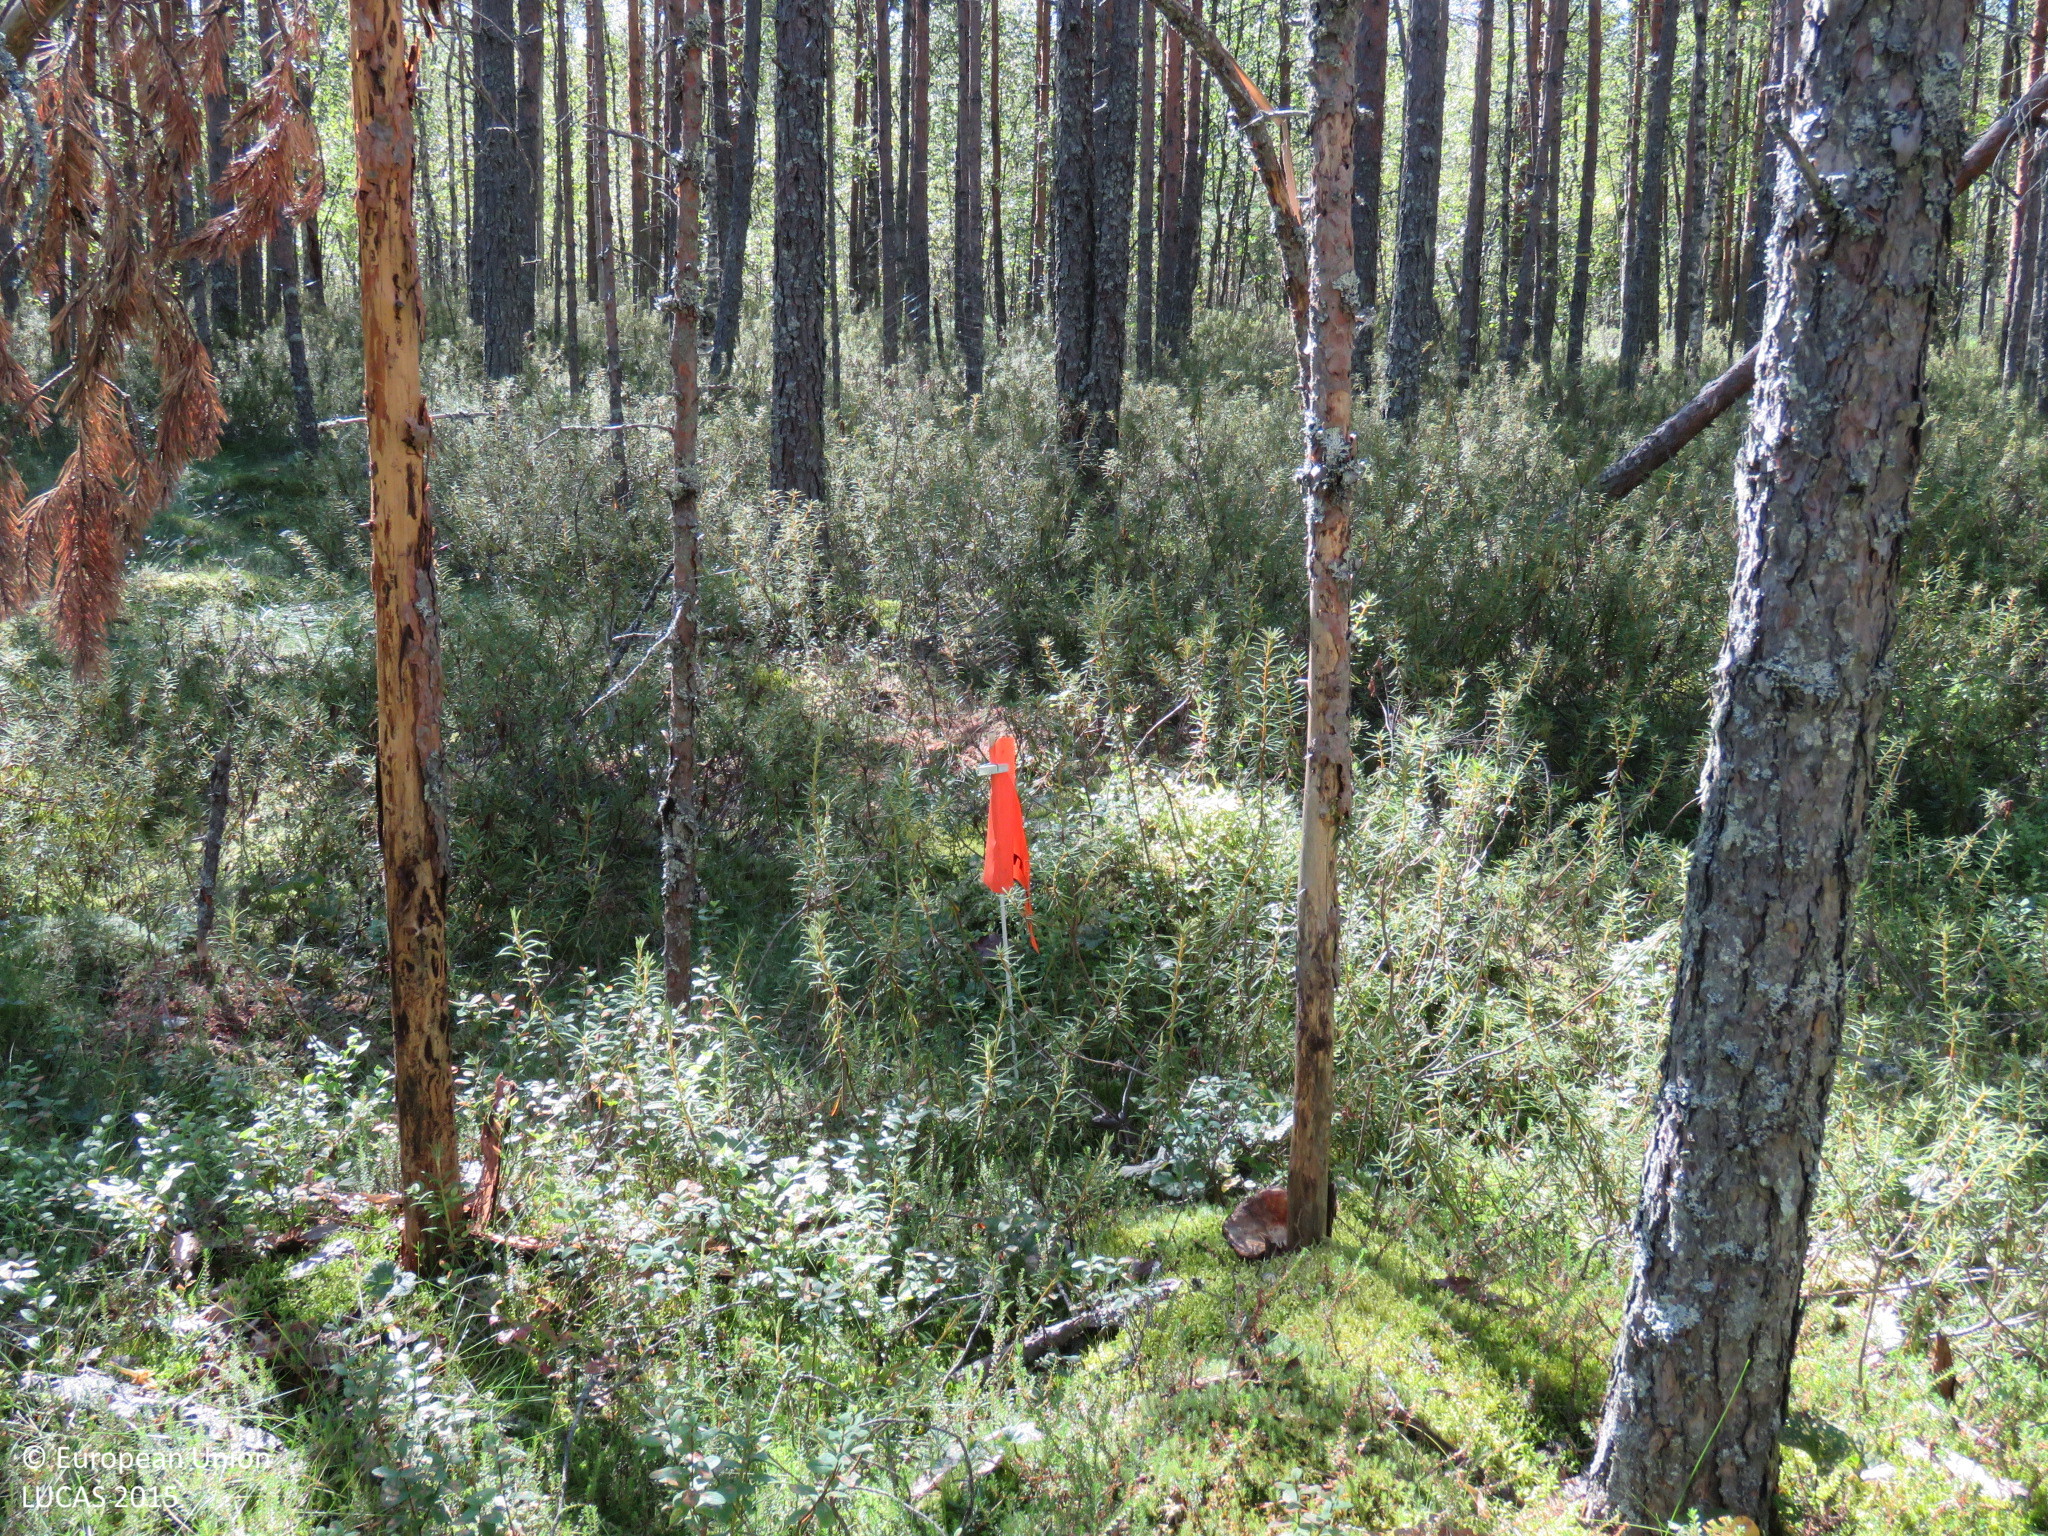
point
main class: Woodland
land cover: Pine dominated coniferous woodland
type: mire and swamp forests
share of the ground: > 75 %
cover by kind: coniferous forest trees 70 %, shrubs 20 %, broadleaved forest trees 5 %, lichens and mosses 5 %
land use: Forestry
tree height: > 5 m
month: August
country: FI
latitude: 65.1480
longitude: 25.6742
